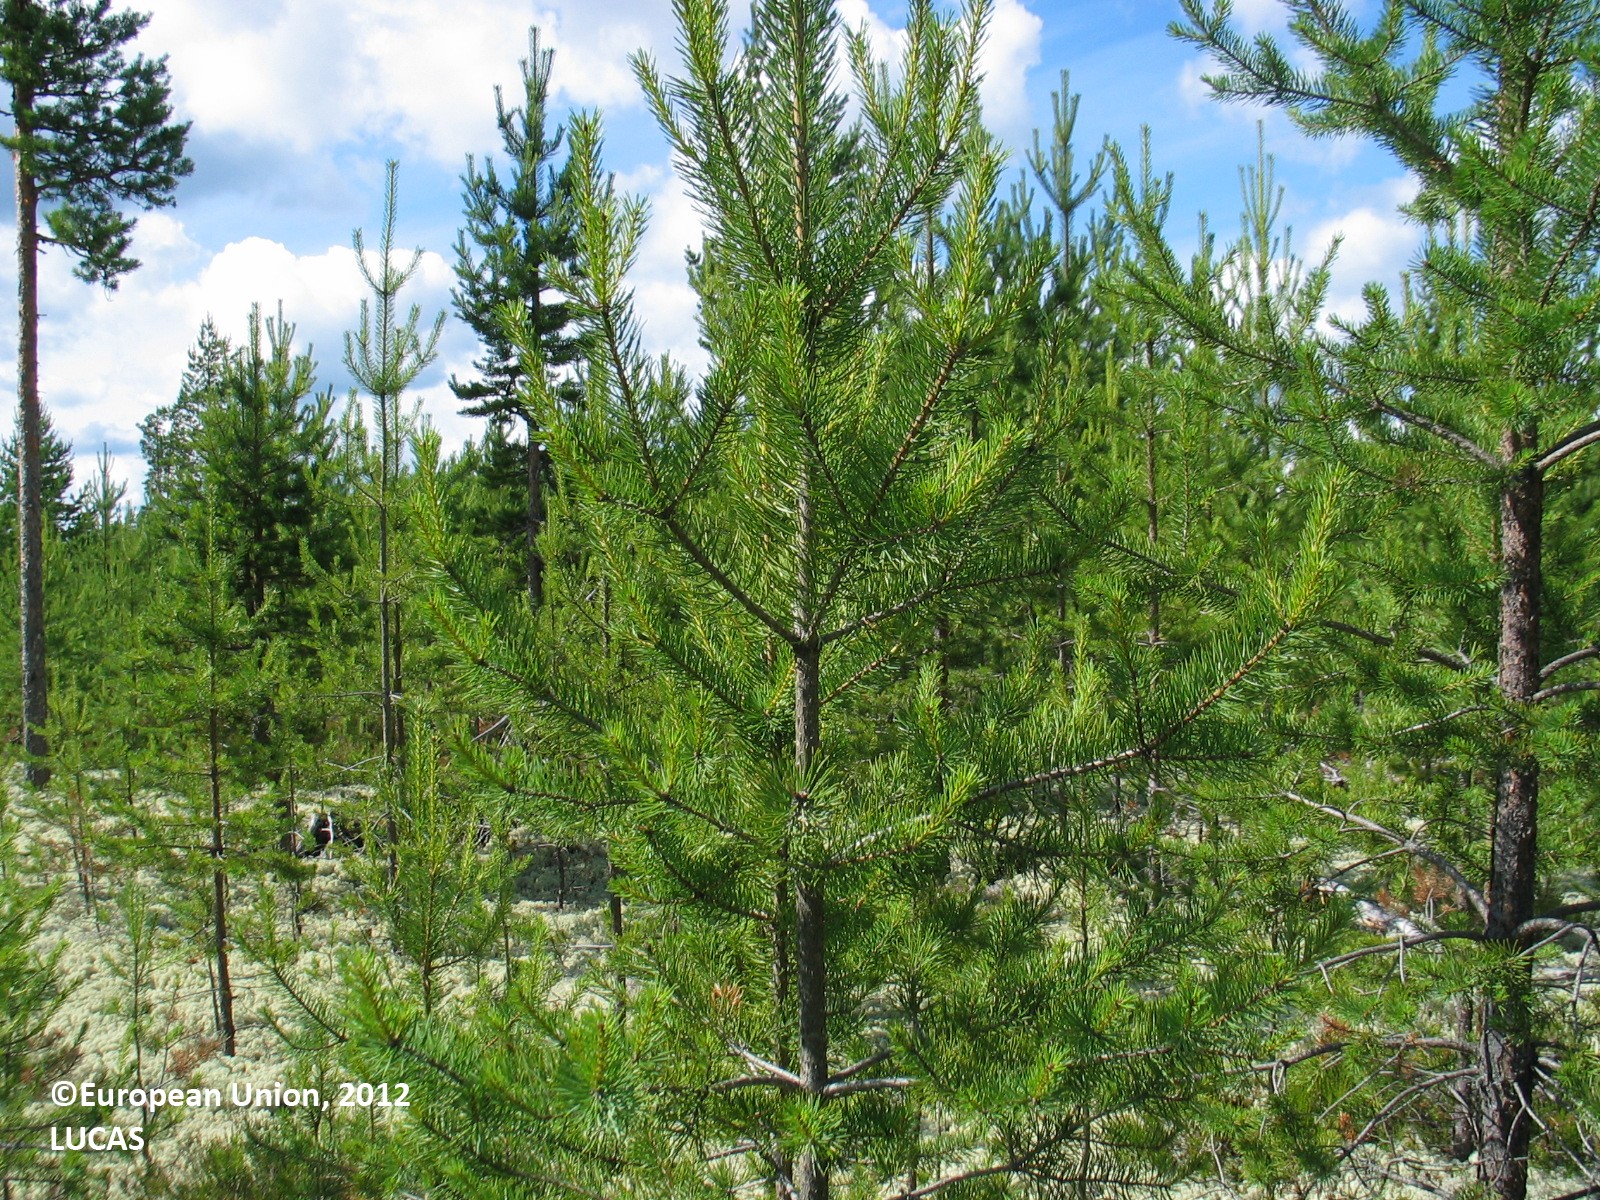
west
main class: Woodland
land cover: Pine dominated coniferous woodland
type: boreal forest
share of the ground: 25 - 50 %
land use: Forestry
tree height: > 5 m
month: July
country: FI
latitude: 64.6077
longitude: 26.4350
